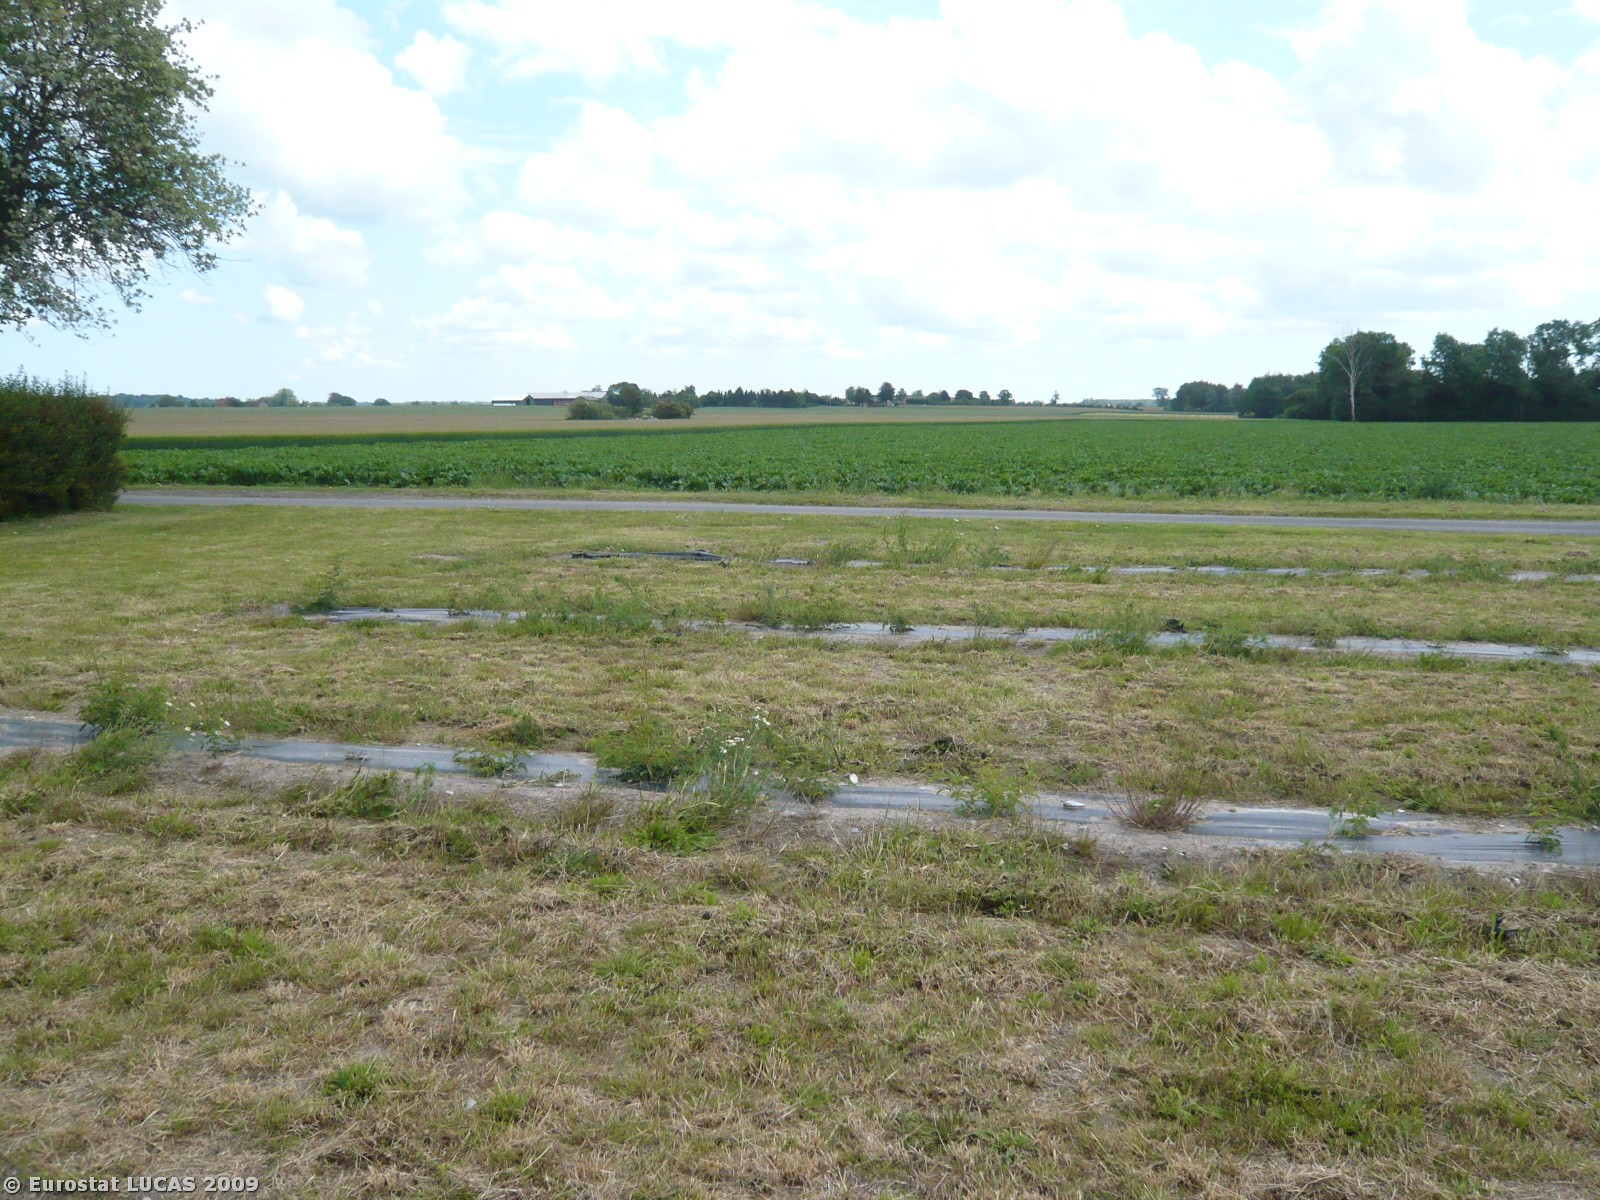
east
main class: Cropland
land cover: Common wheat
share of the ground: 10 - 25 %
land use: Agriculture (excluding fallow land and kitchen gardens)
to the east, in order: Common wheat; Grassland without tree/shrub cover; Paved roads, cycling and walking lanes; Grass margins; Sugar beet; Barley
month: June
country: DK
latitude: 54.7572
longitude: 11.6305
